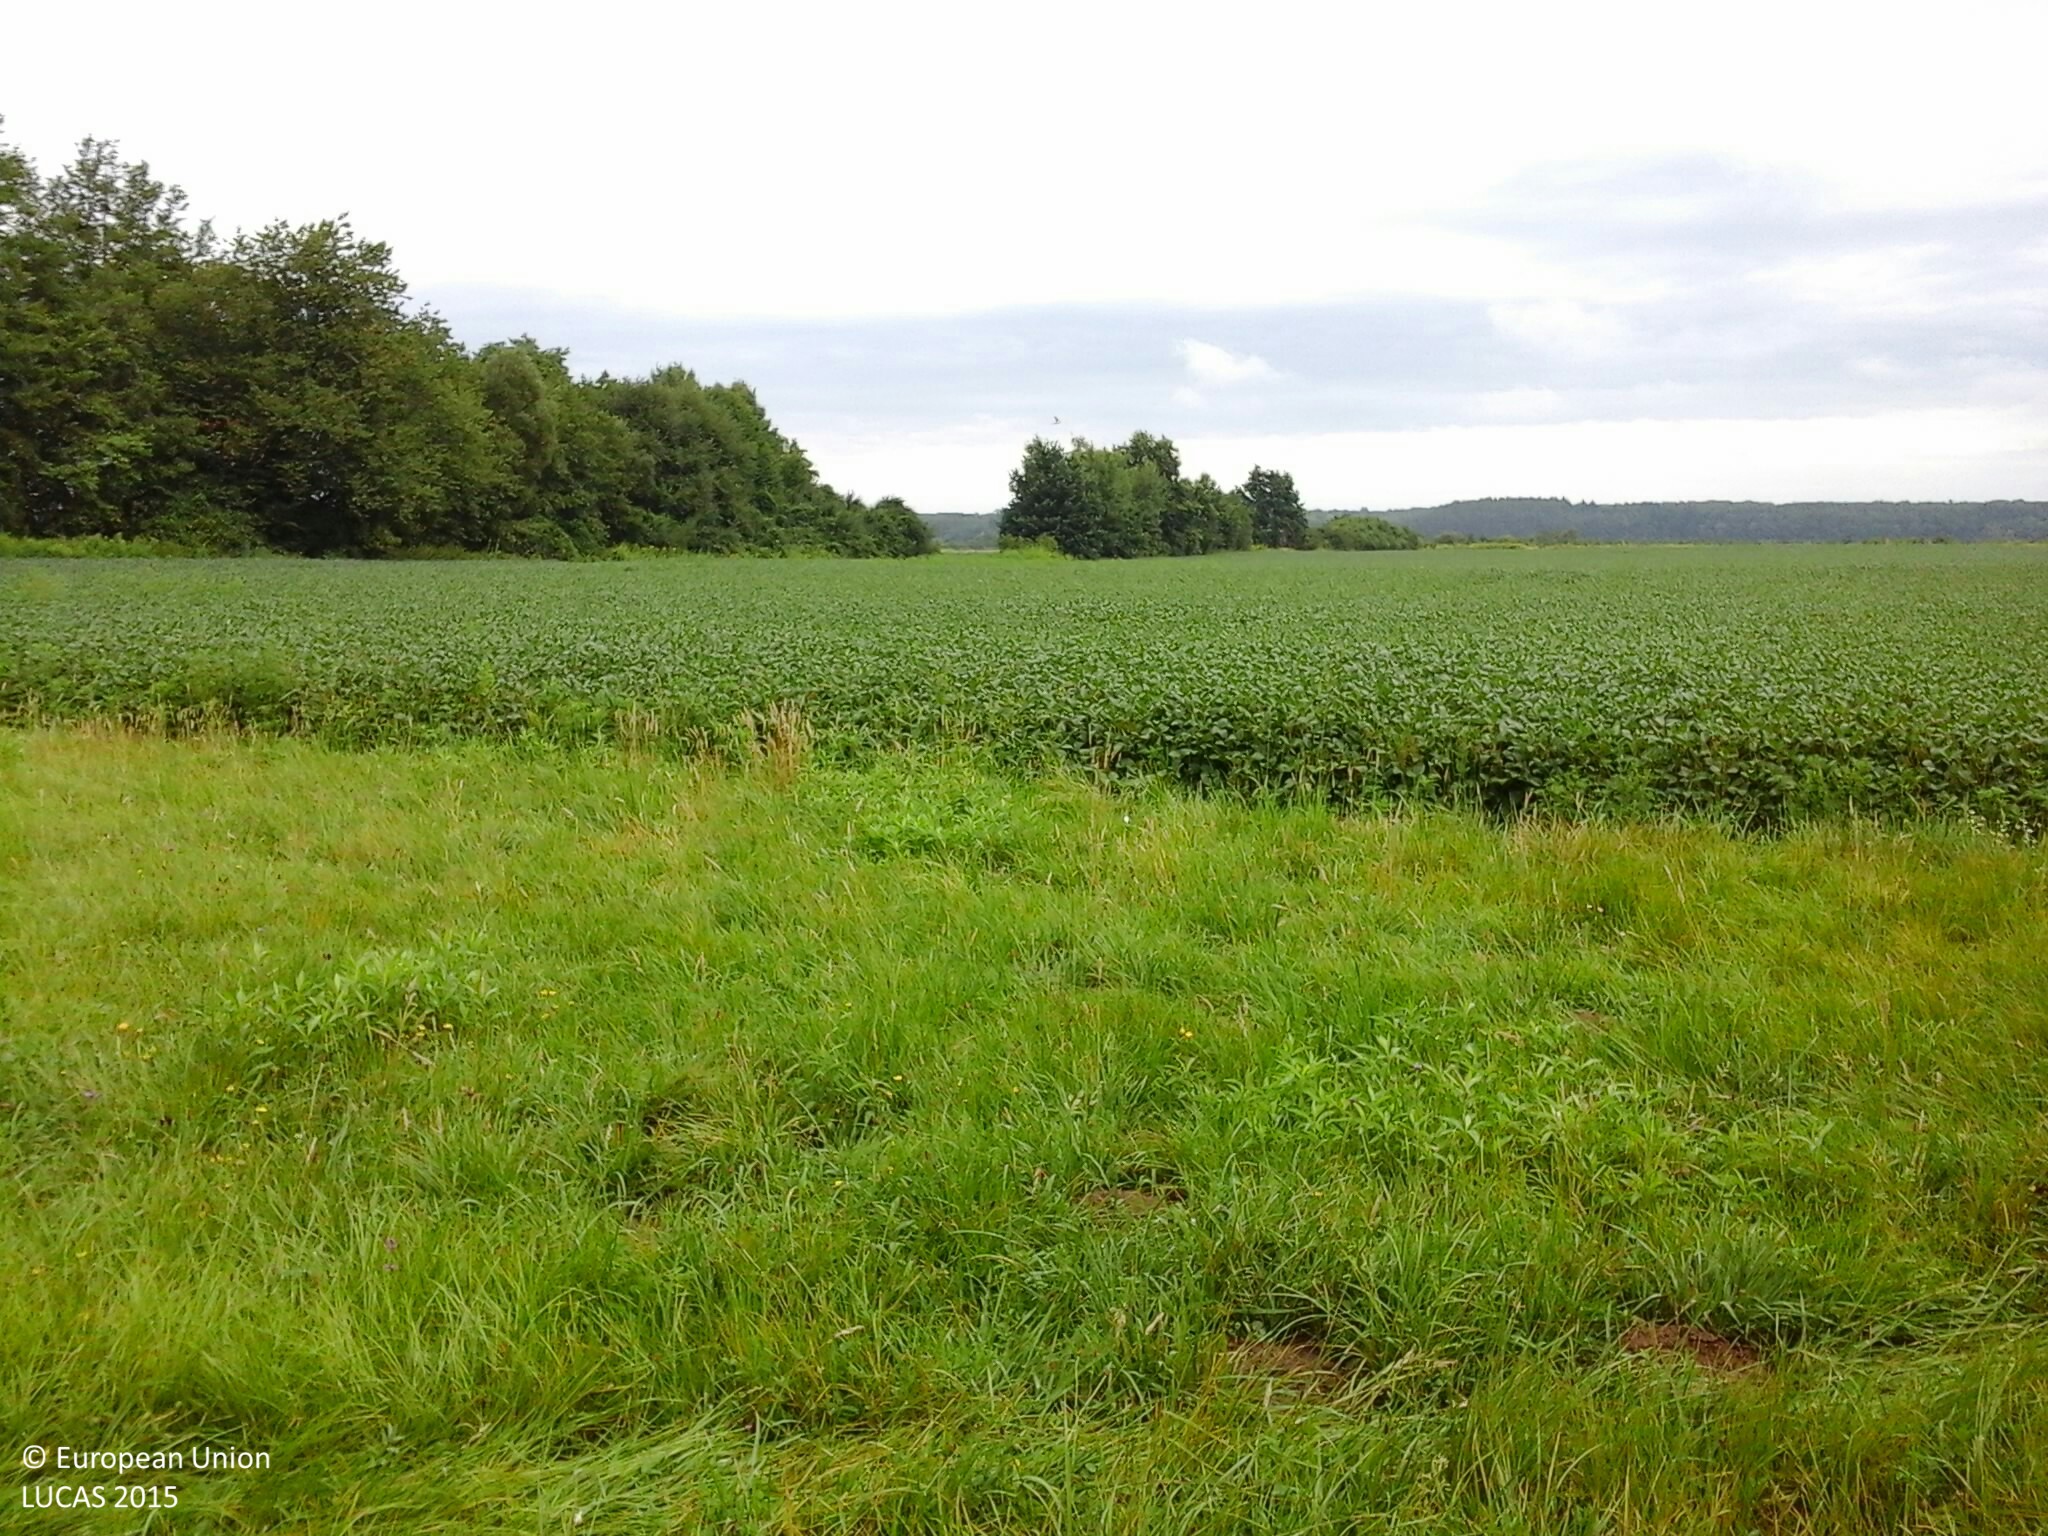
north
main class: Grassland
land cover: Grassland without tree/shrub cover
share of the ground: > 75 %
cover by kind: herbaceous plants 100 %
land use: Agriculture (excluding fallow land and kitchen gardens)
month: July
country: HU
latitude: 46.7390
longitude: 16.3751
